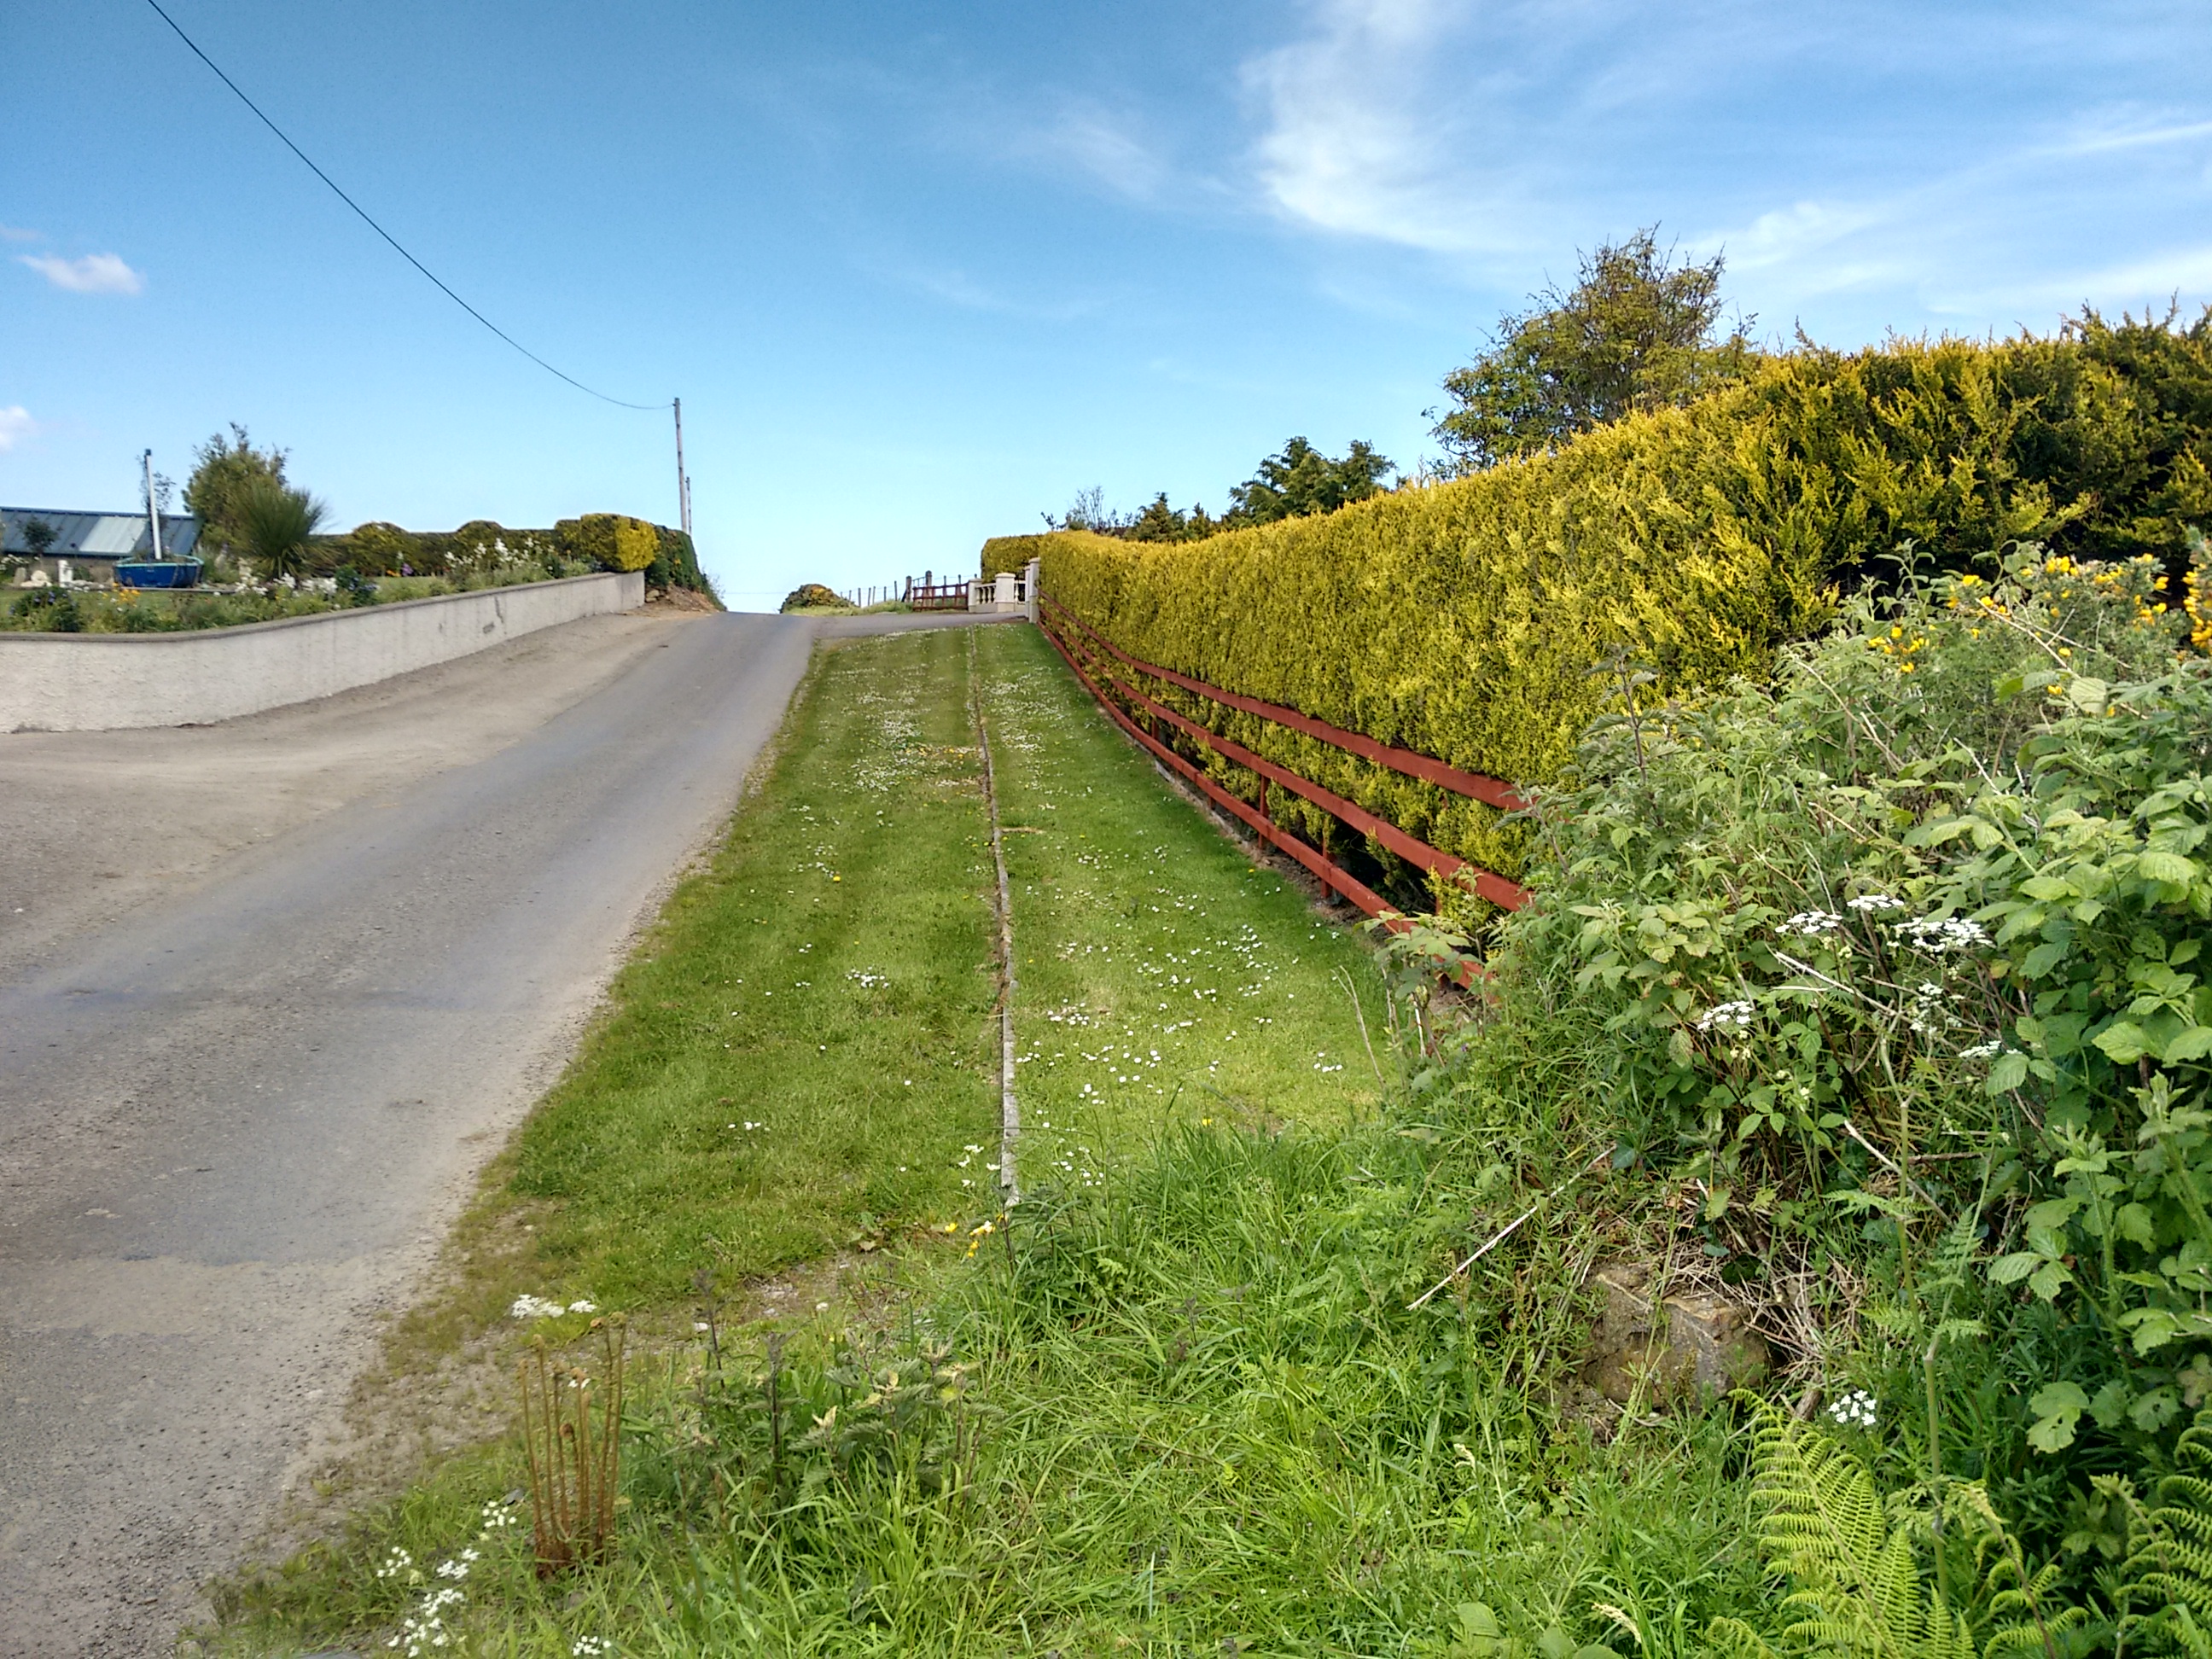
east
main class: Grassland
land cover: Grassland without tree/shrub cover
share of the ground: > 75 %
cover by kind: herbaceous plants 100 %
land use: Agriculture (excluding fallow land and kitchen gardens)
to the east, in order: Grassland without tree/shrub cover; Managed hedges; Fences; Grassland without tree/shrub cover; Abandoned hedges; Fences; Artificial constructions in urban areas; Grassland without tree/shrub cover; Fences; Abandoned hedges; Grassland without tree/shrub cover
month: June
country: GB
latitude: 54.7086
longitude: -7.3950
